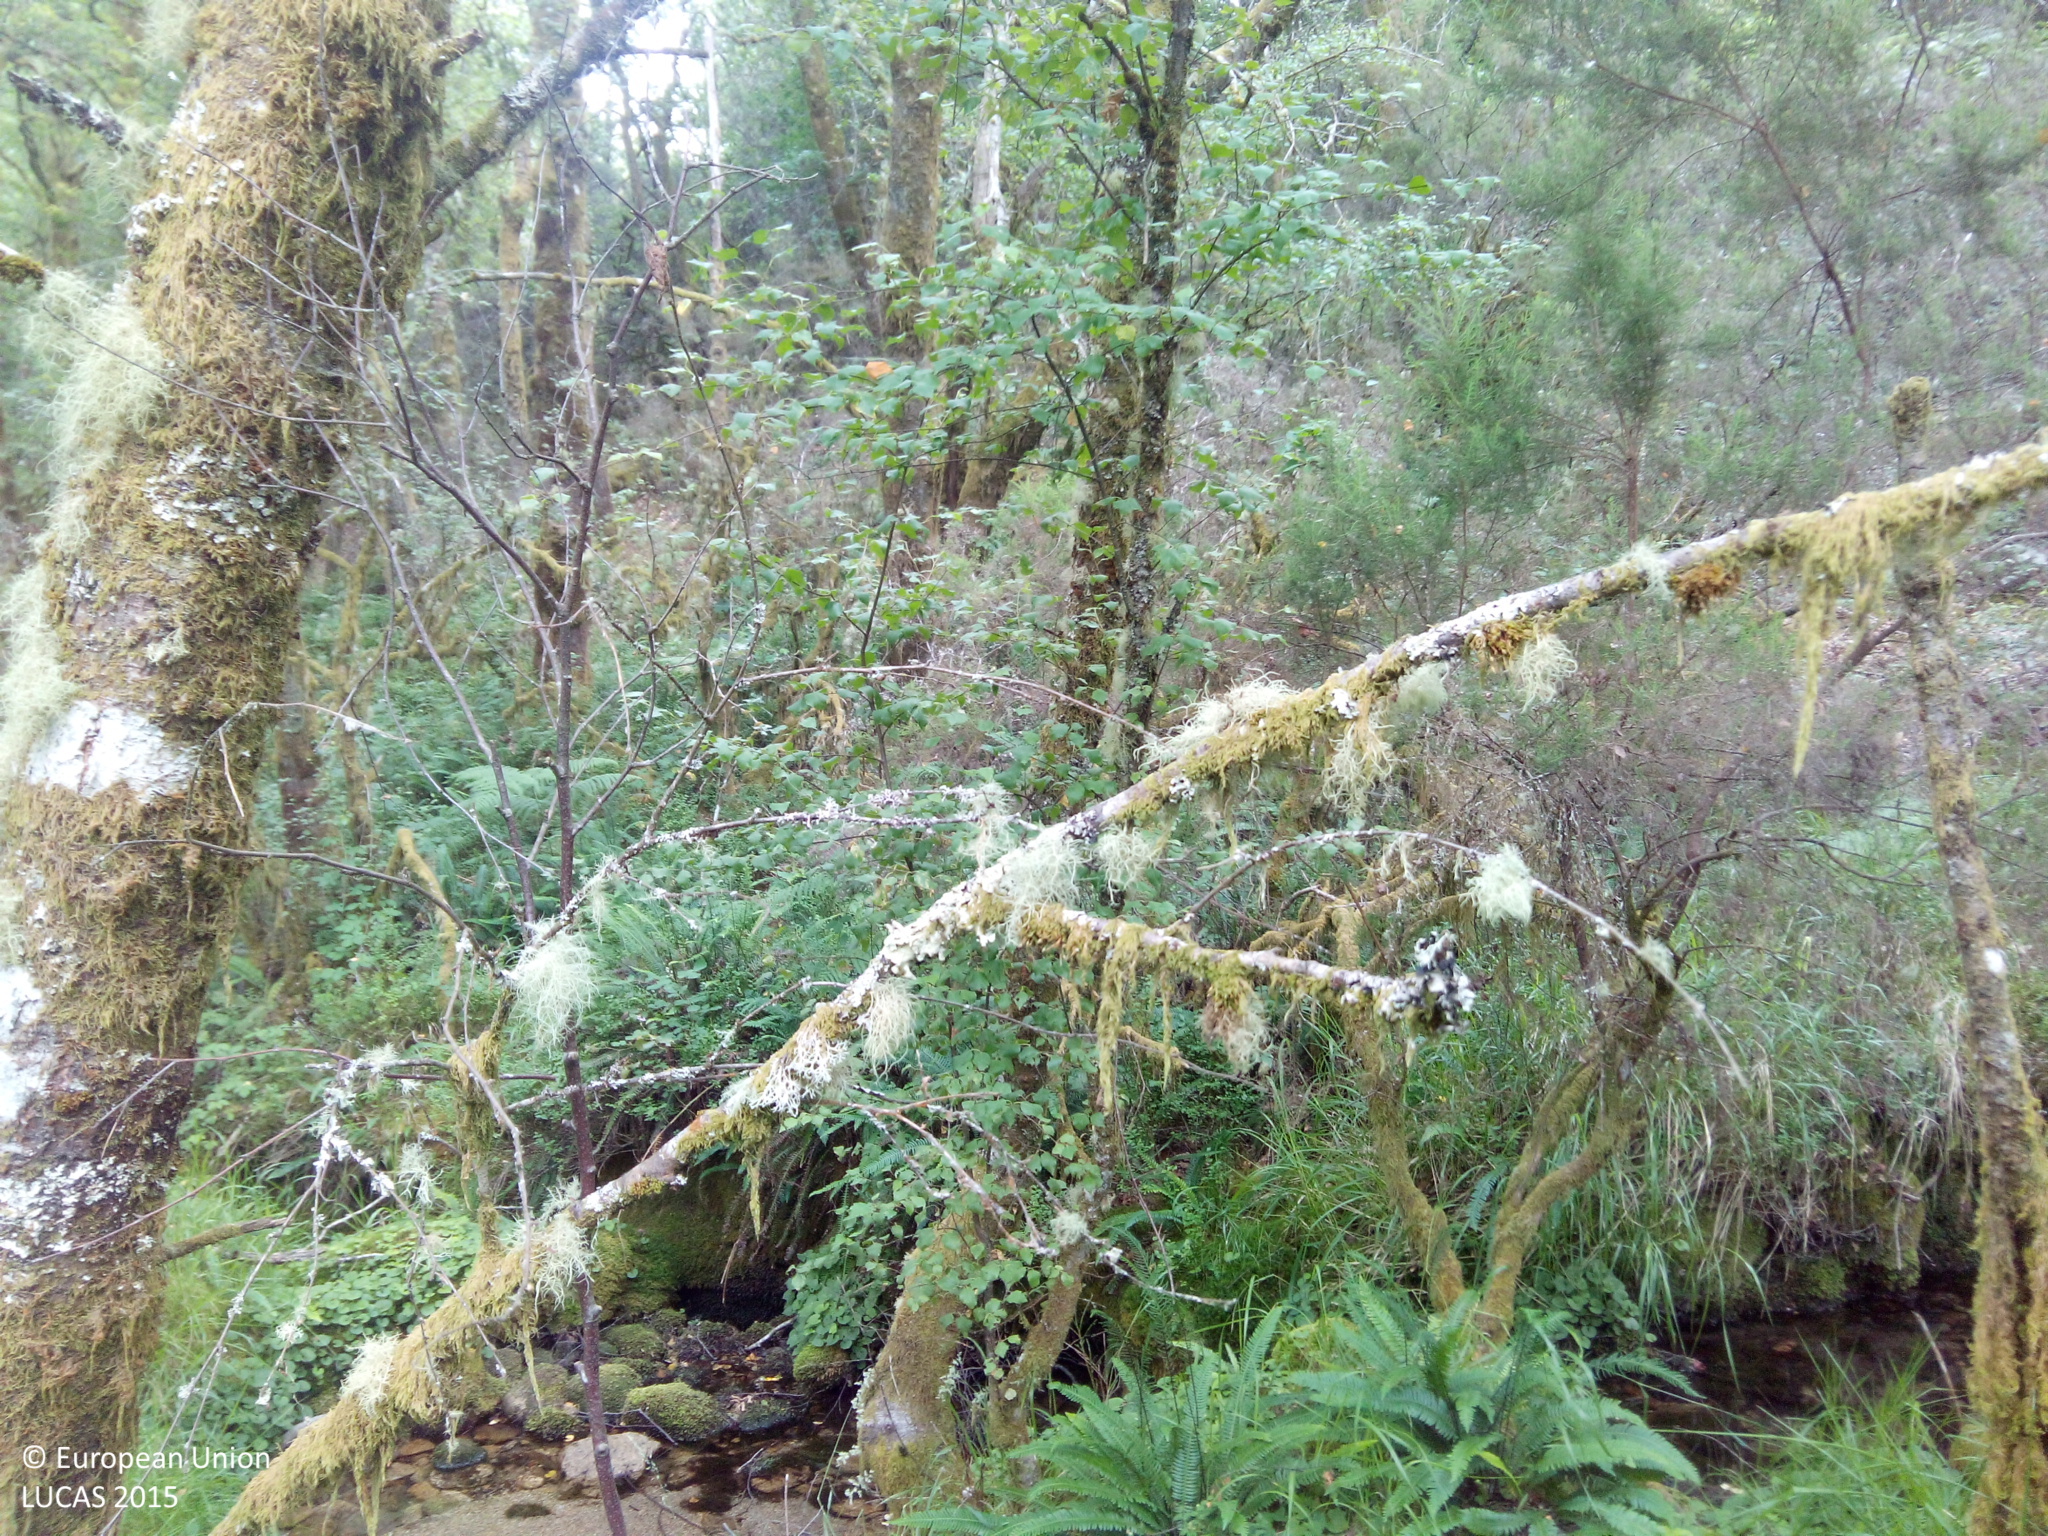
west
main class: Shrubland
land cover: Shrubland without tree cover
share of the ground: 10 - 25 %
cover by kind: consolidated bare surface 80 %, shrubs 20 %
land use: Semi-natural and natural areas not in use
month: July
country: ES
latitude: 42.2742
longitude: -8.2382
